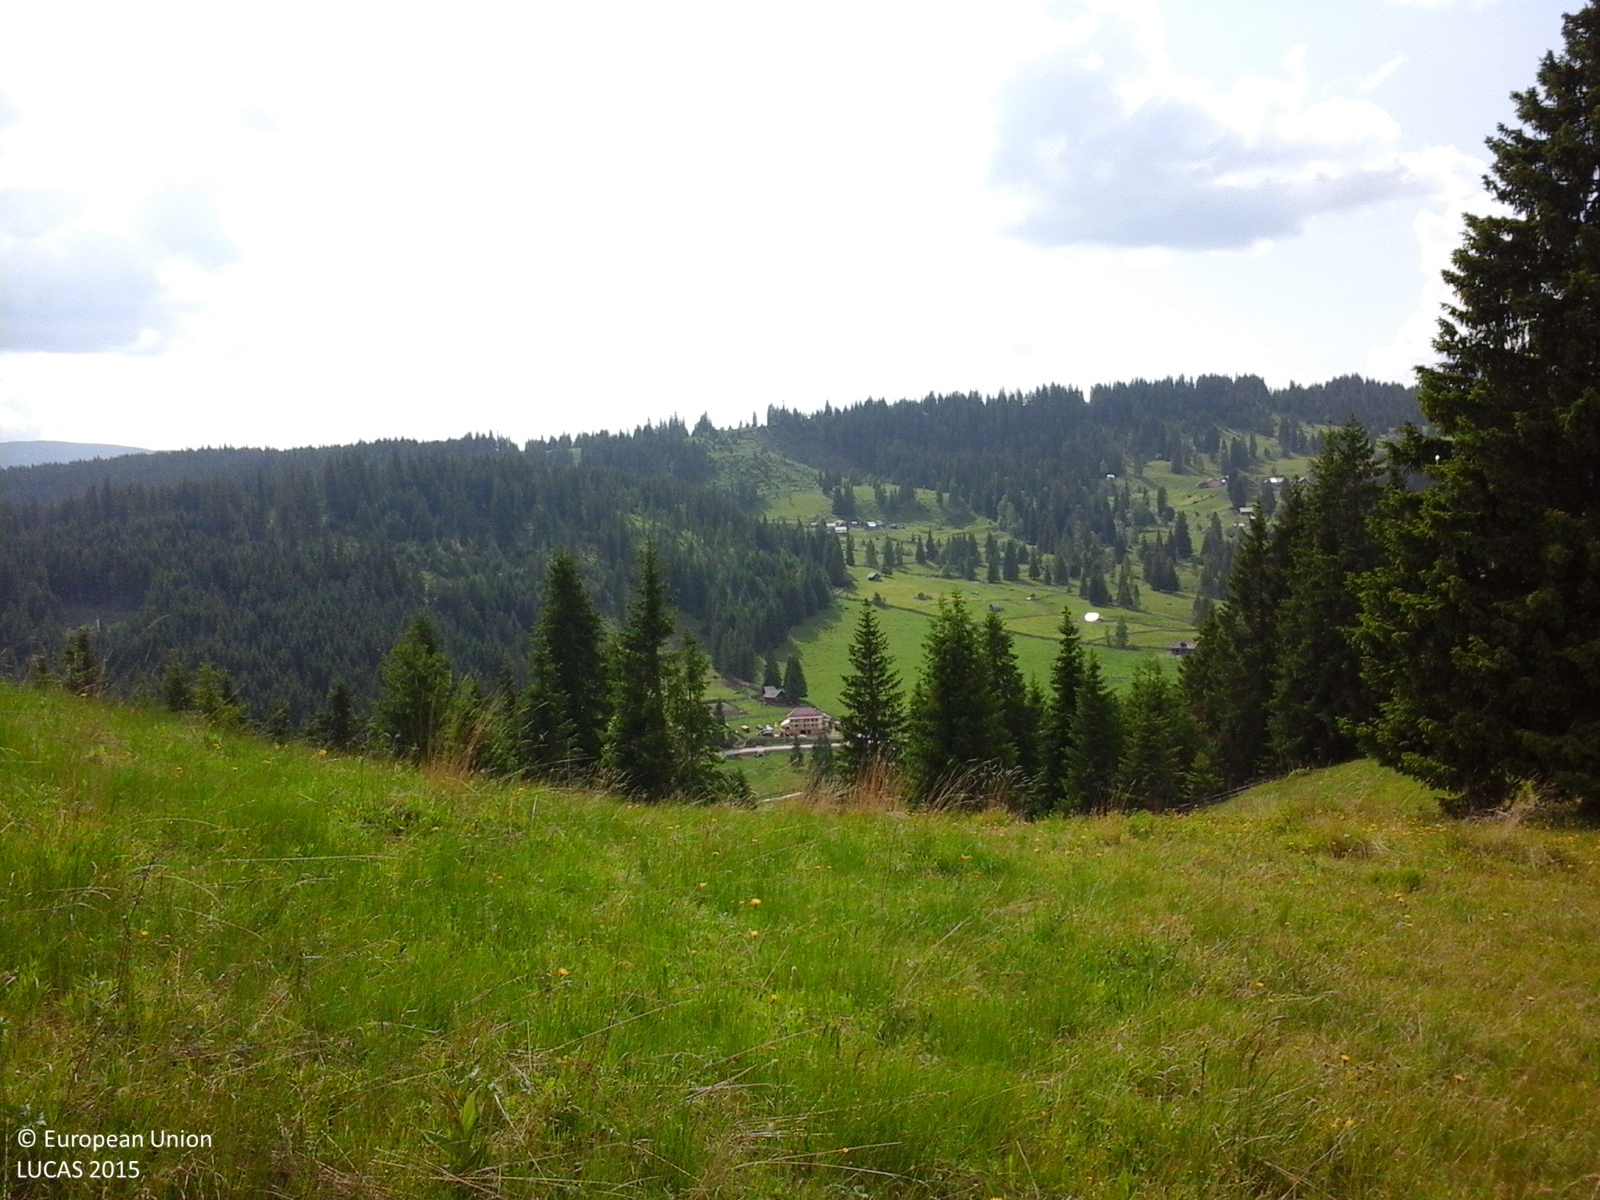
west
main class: Grassland
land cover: Grassland without tree/shrub cover
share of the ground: > 75 %
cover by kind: herbaceous plants 100 %
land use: Agriculture (excluding fallow land and kitchen gardens)
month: June
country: RO
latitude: 47.1831
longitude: 25.4331
